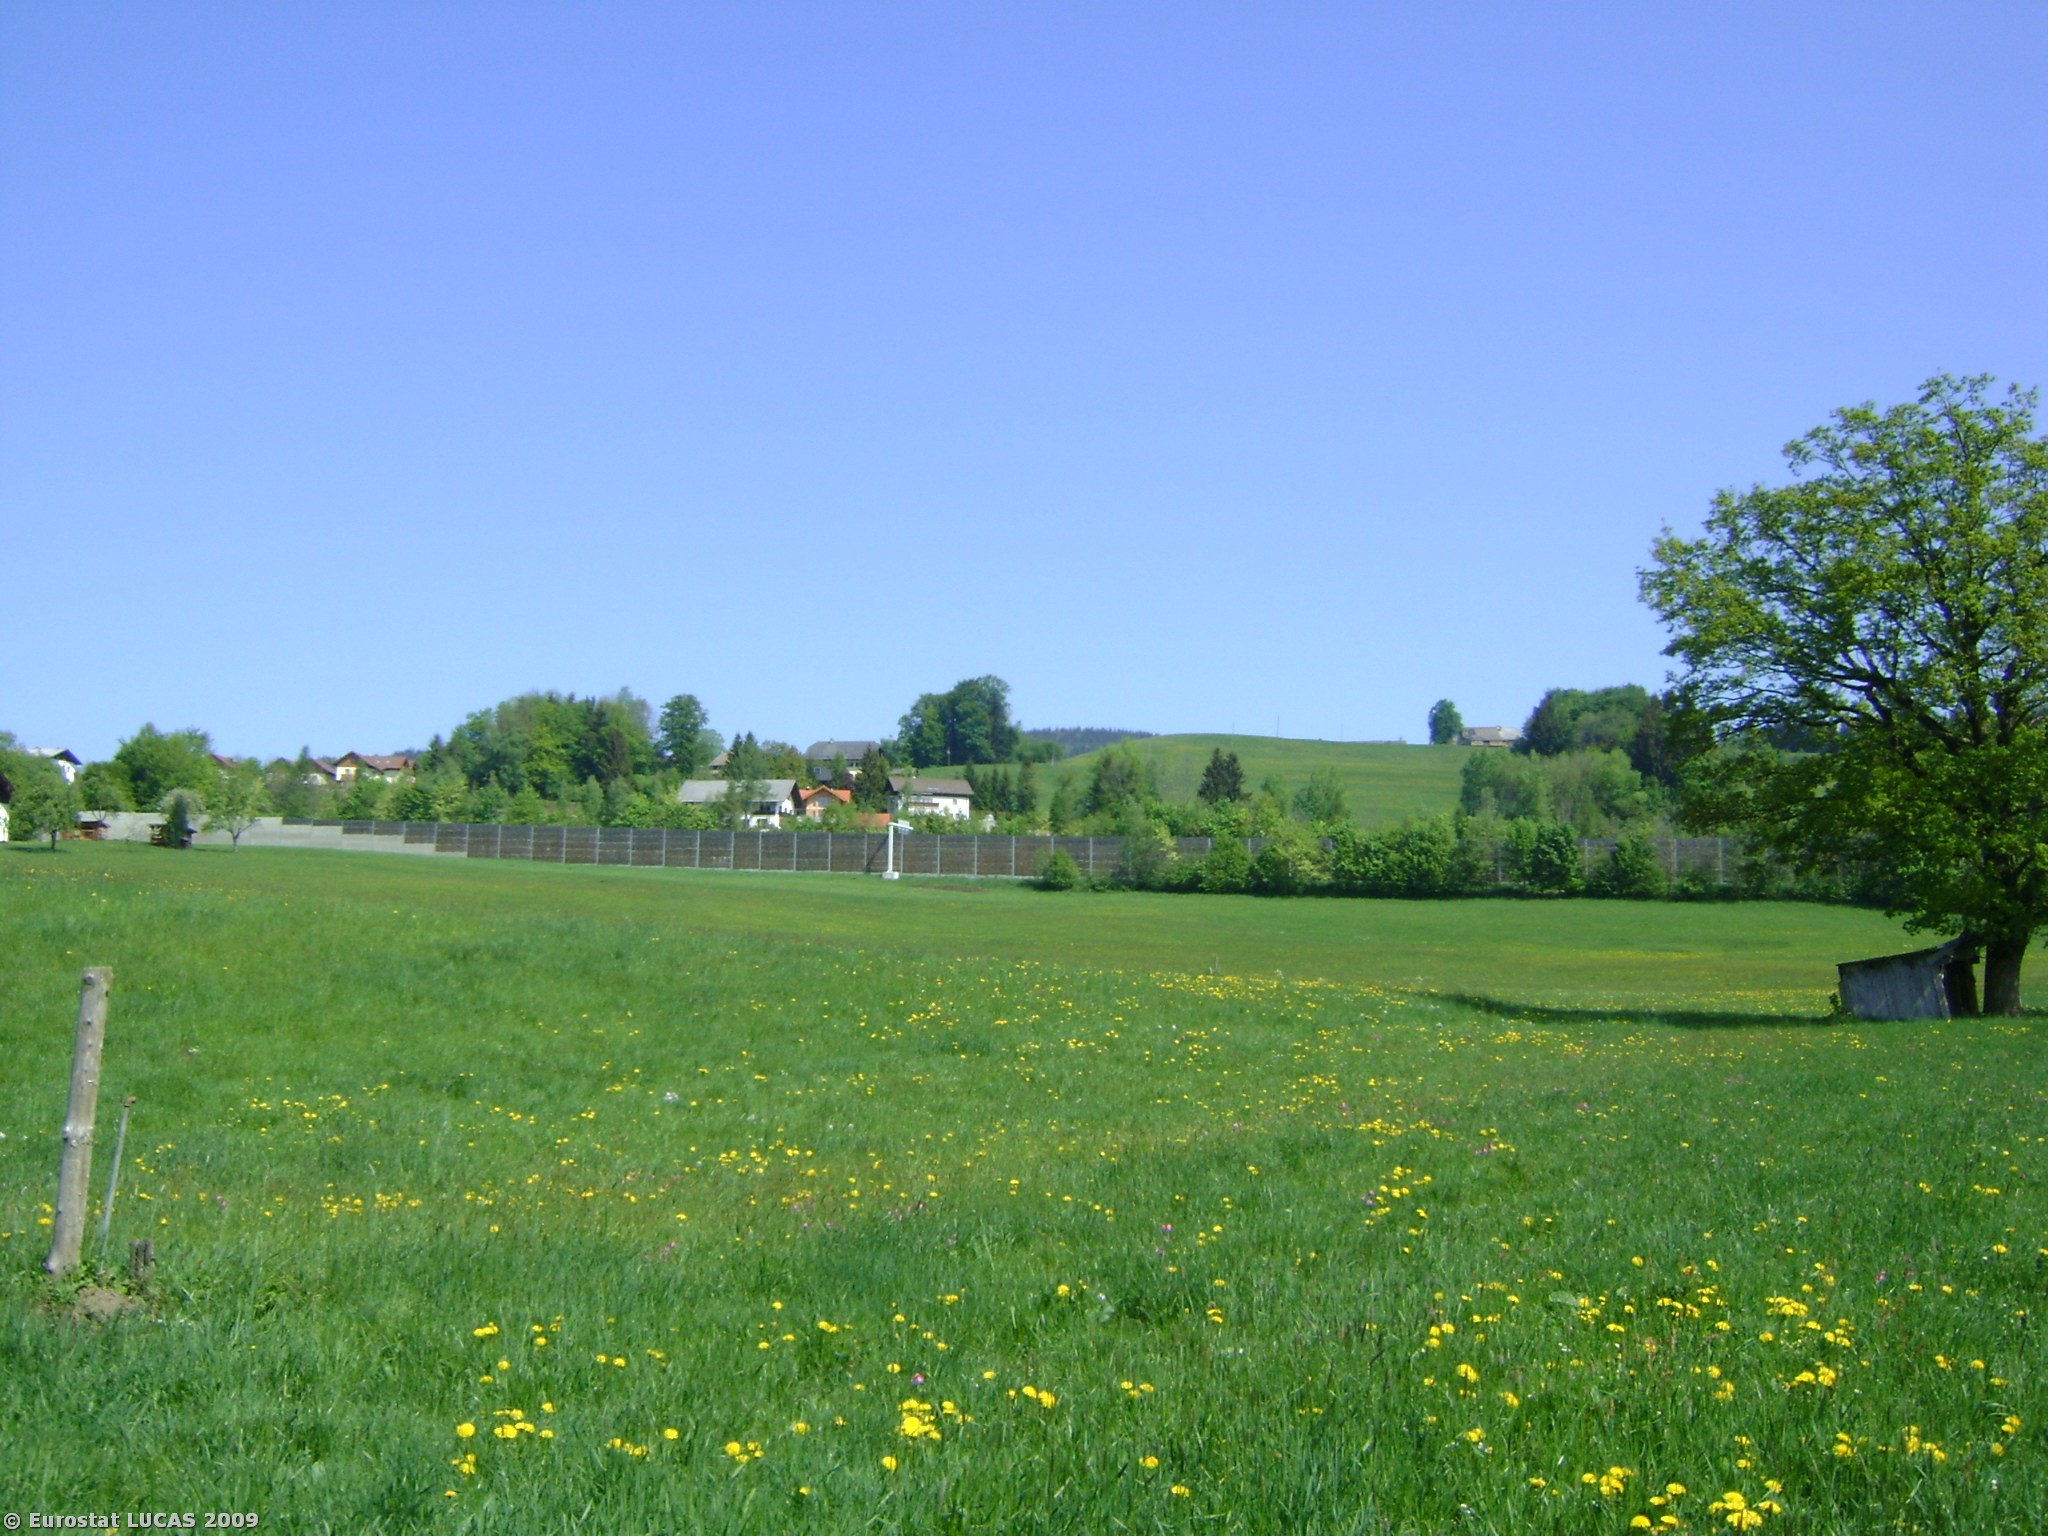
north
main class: Grassland
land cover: Grassland without tree/shrub cover
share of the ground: > 75 %
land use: Agriculture (excluding fallow land and kitchen gardens)
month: May
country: AT
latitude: 47.8524
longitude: 13.2196
